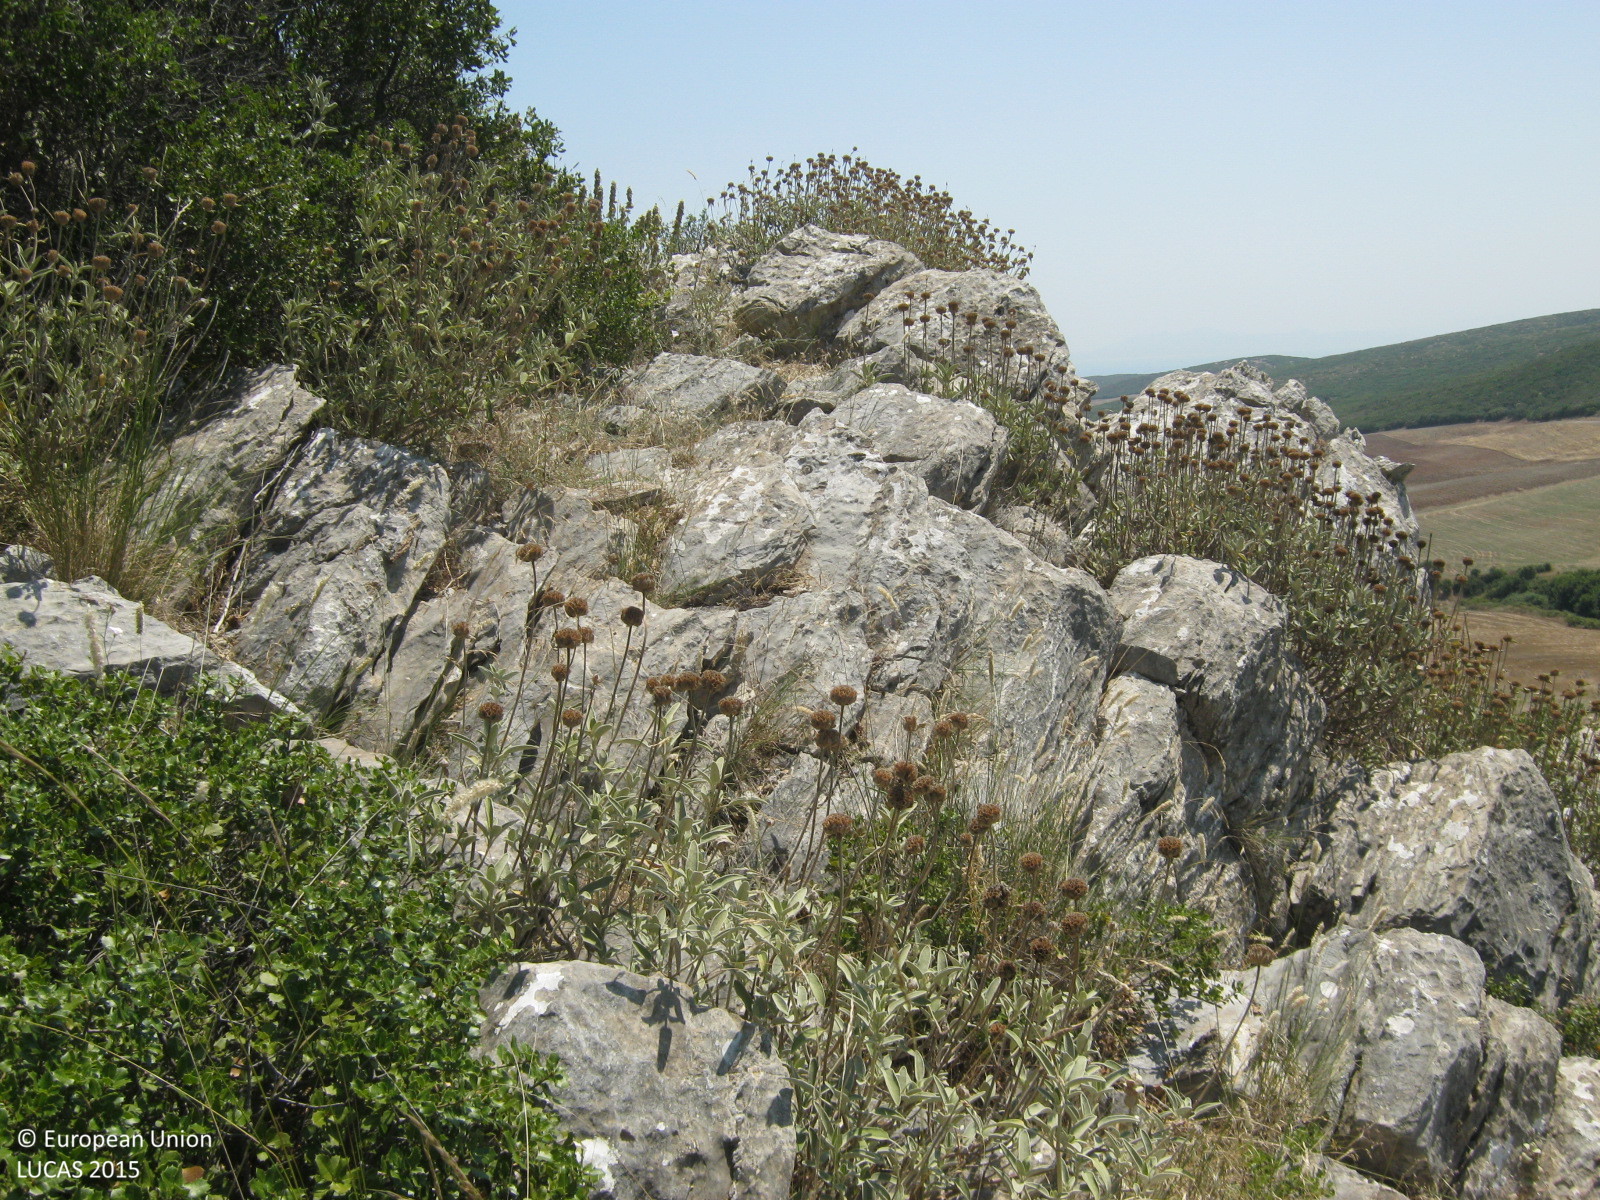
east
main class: Shrubland
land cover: Shrubland without tree cover
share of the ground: 50 - 75 %
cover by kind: shrubs 70 %, unconsolidated bare surface 20 %, herbaceous plants 10 %
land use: Abandoned areas
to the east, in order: Shrubland without tree cover; Rocks and stones; Shrubland without tree cover
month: July
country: GR
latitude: 39.2971
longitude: 22.6615
